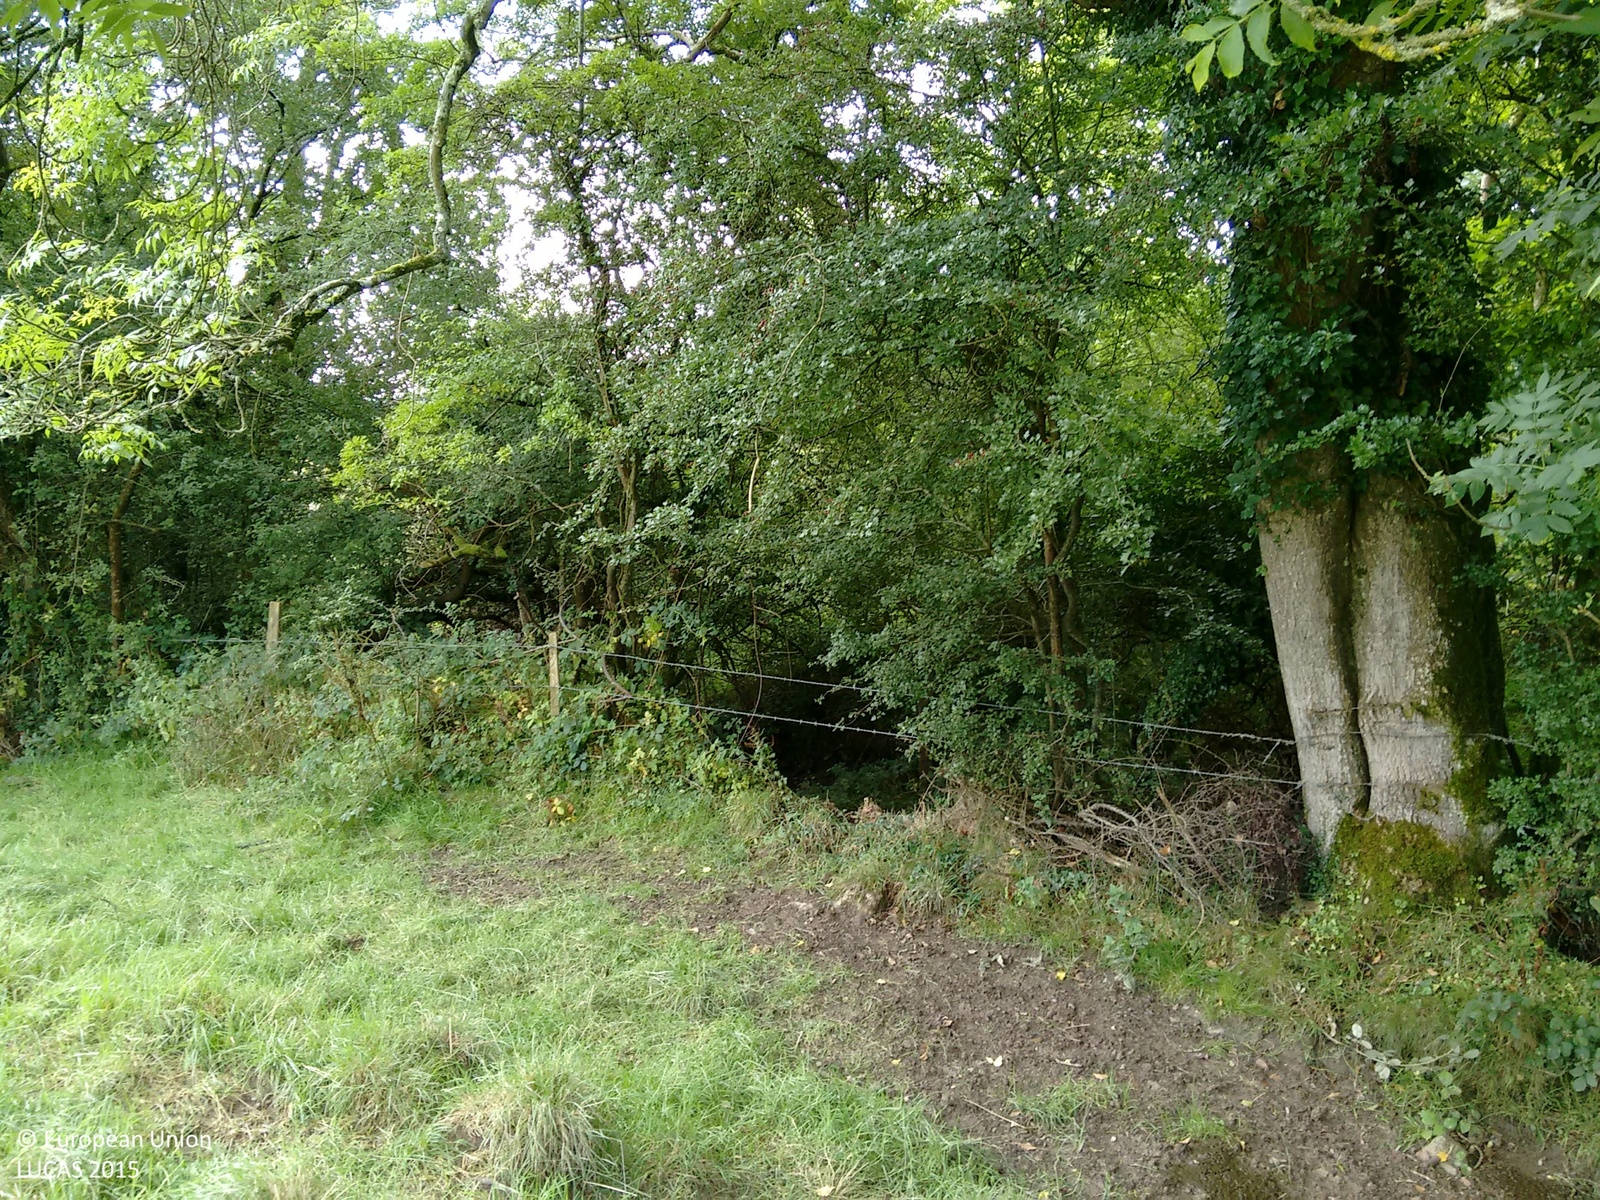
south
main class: Woodland
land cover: Broadleaved woodland
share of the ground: > 75 %
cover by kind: broadleaved forest trees 90 %, herbaceous plants 10 %
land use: Agriculture (excluding fallow land and kitchen gardens)
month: September
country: GB
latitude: 52.0653
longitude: -4.5030
